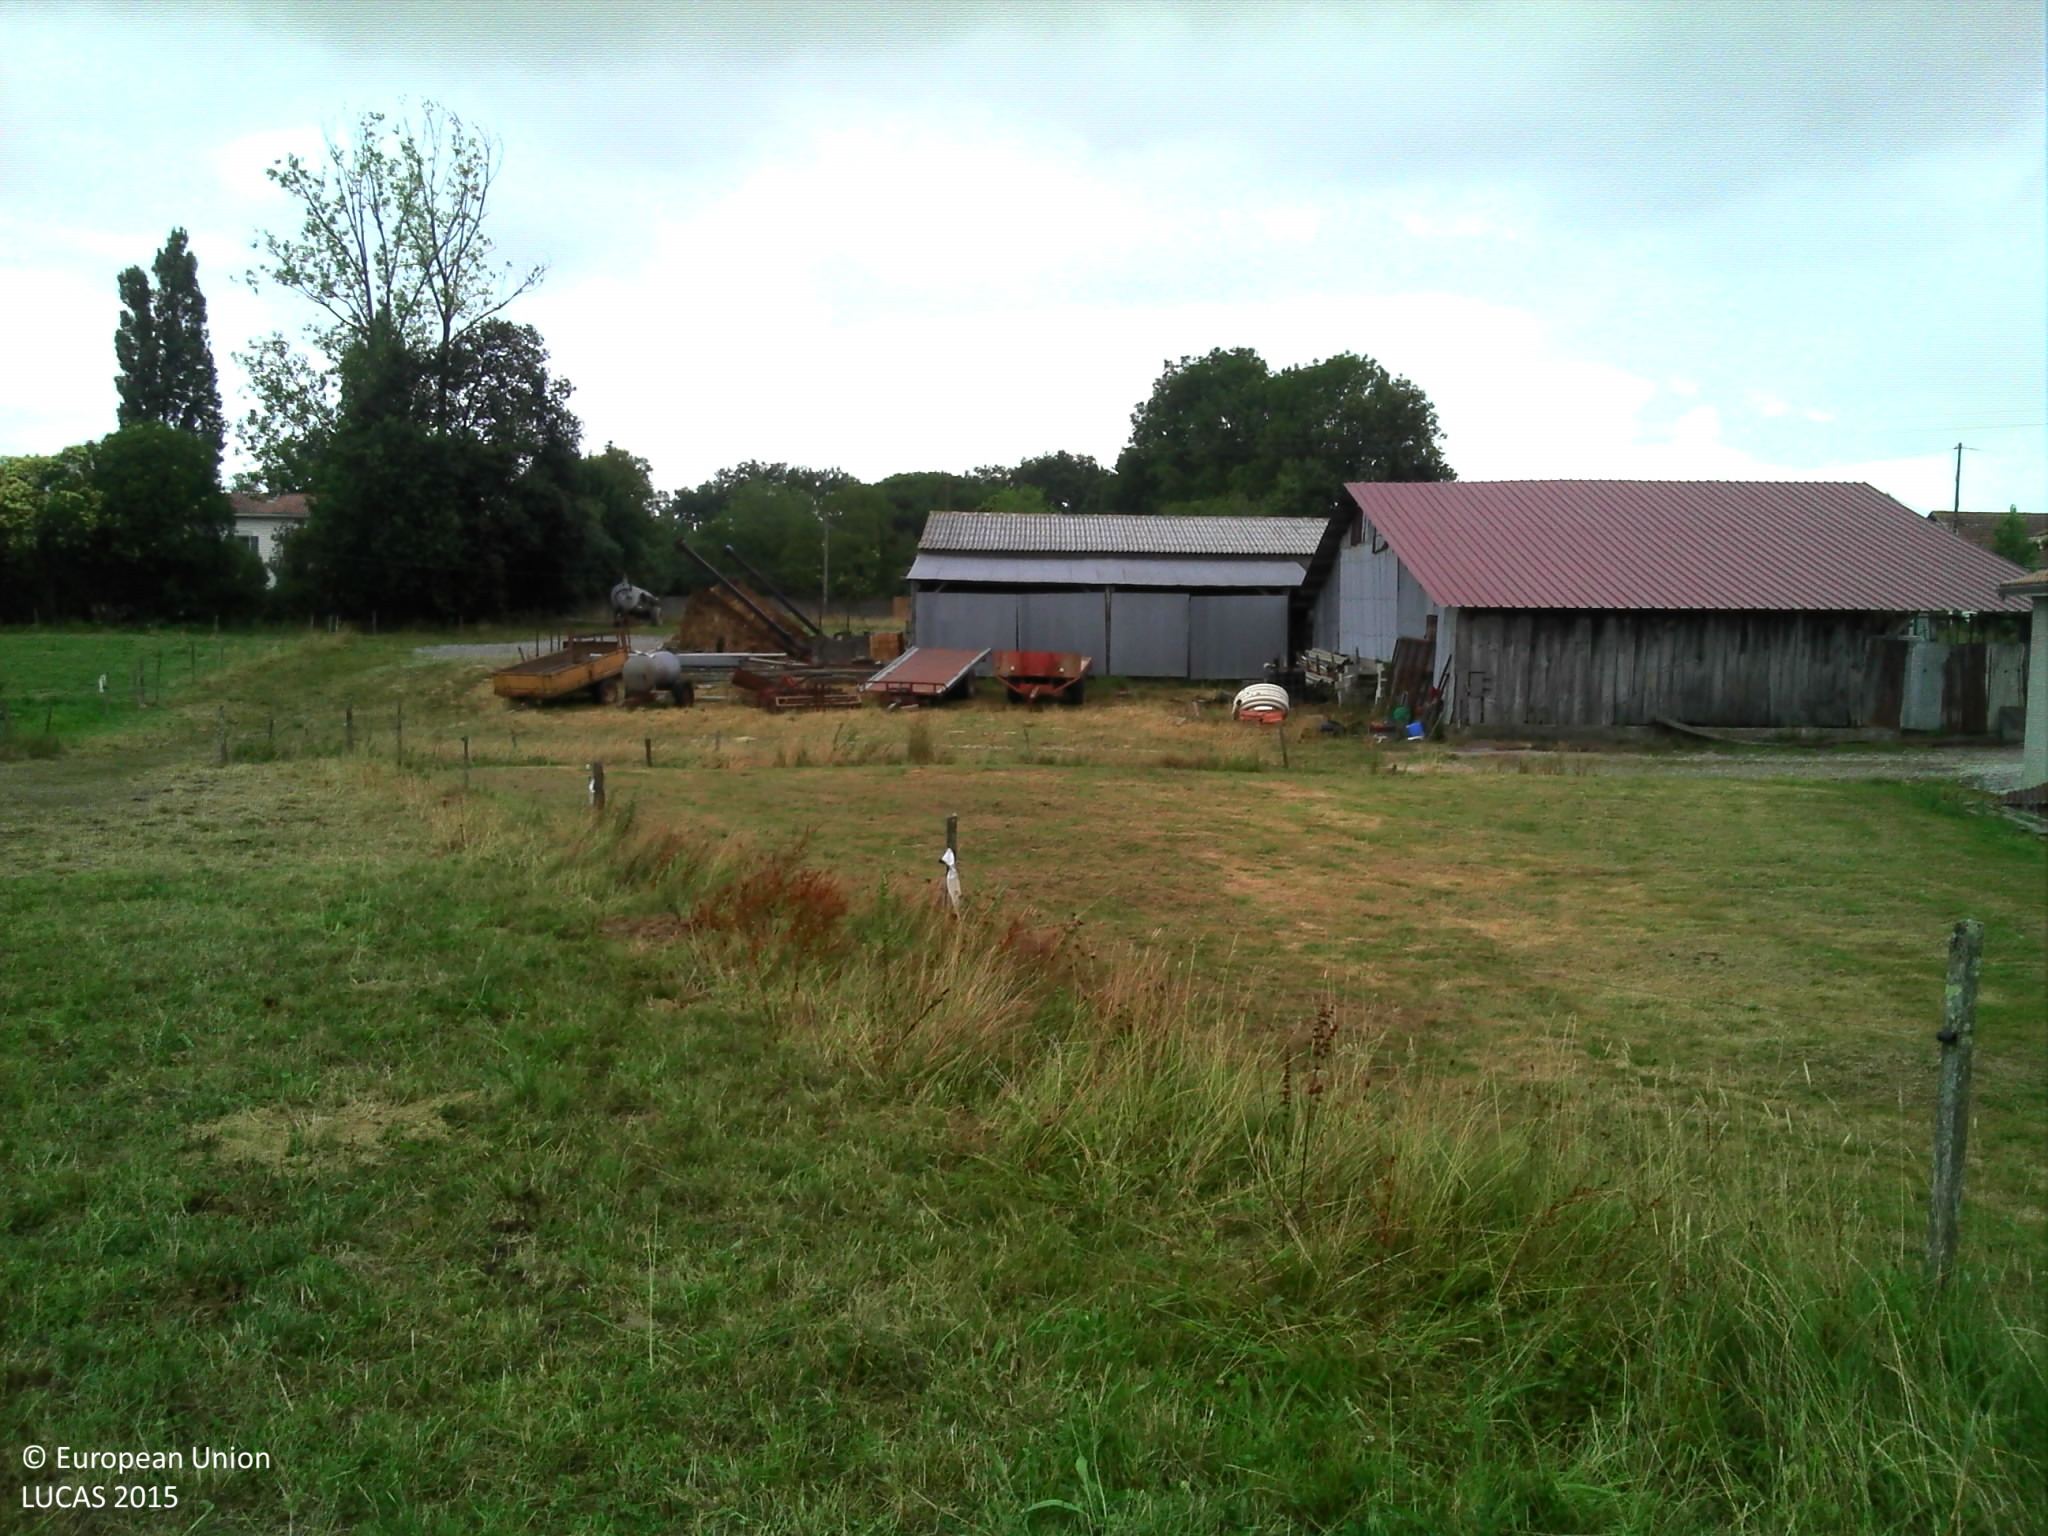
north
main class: Grassland
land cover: Grassland without tree/shrub cover
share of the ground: > 75 %
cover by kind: herbaceous plants 90 %, unconsolidated bare surface 10 %
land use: Agriculture (excluding fallow land and kitchen gardens)
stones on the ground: < 10 %
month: July
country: FR
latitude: 43.6375
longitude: -1.1599
